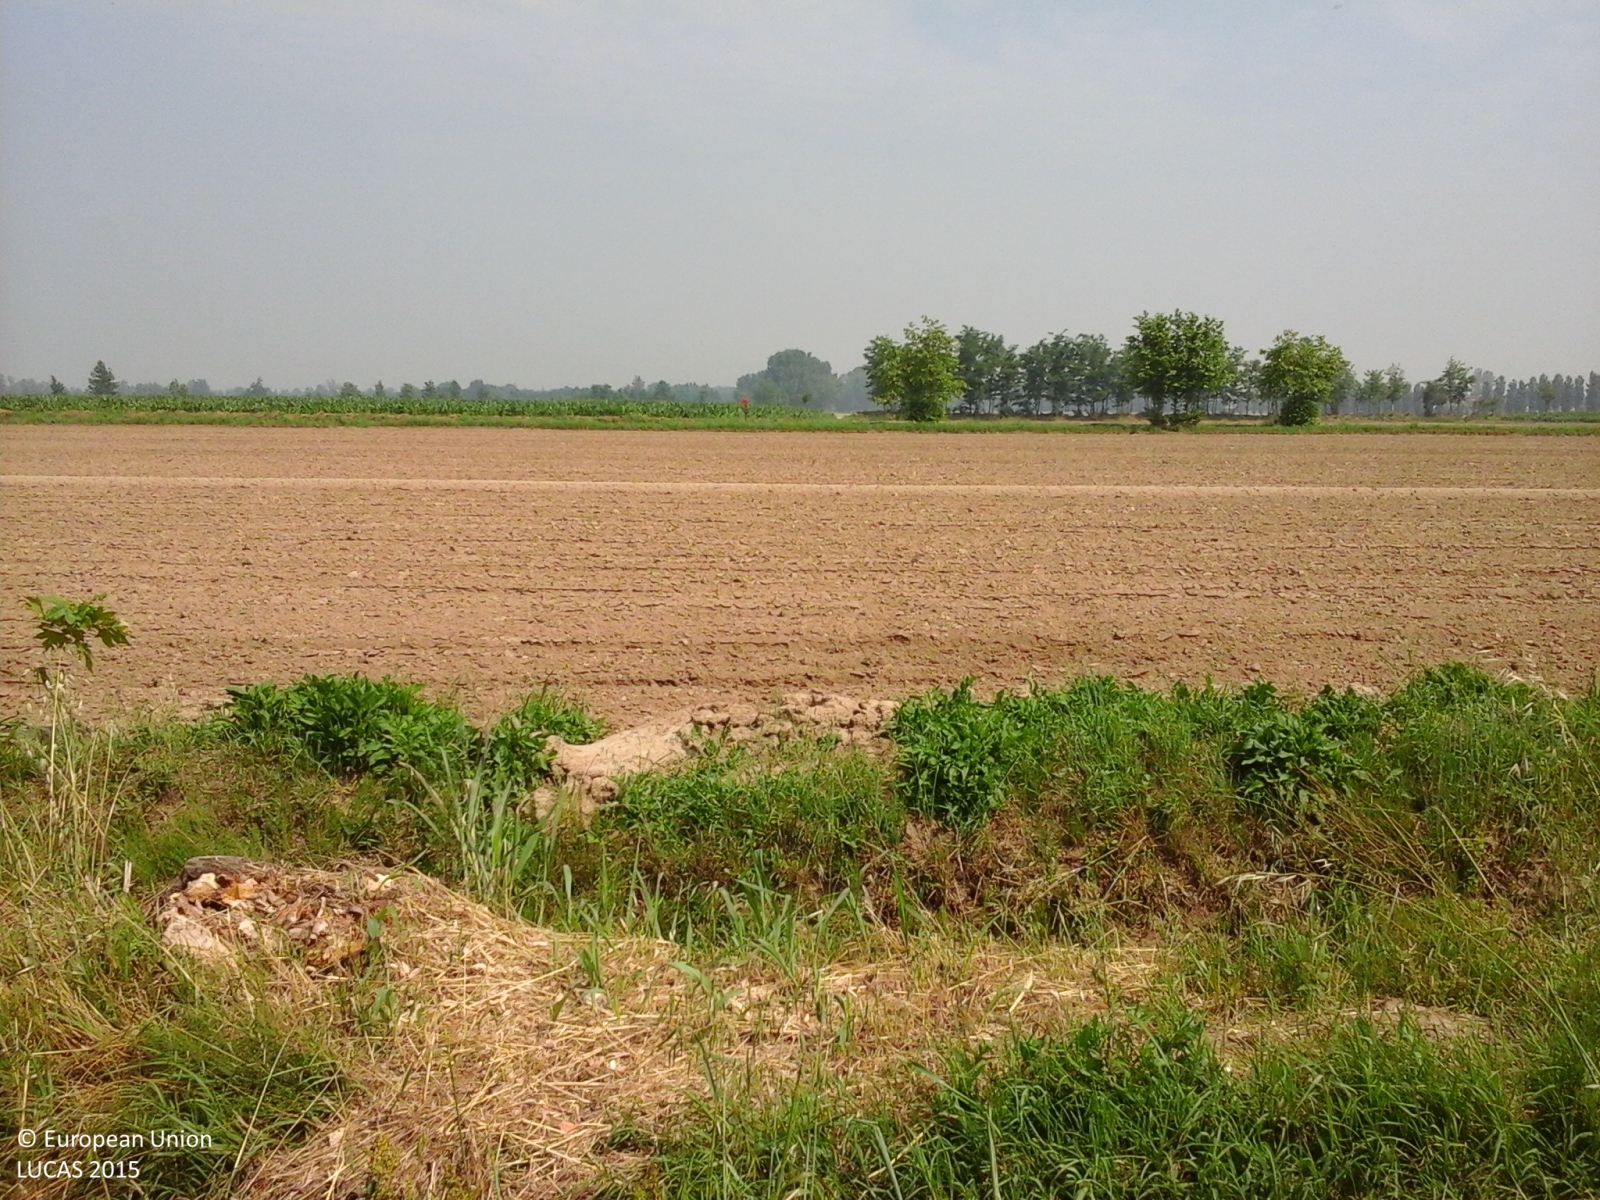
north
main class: Cropland
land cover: Maize
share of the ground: > 75 %
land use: Agriculture (excluding fallow land and kitchen gardens)
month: June
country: IT
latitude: 45.3782
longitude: 10.0637
